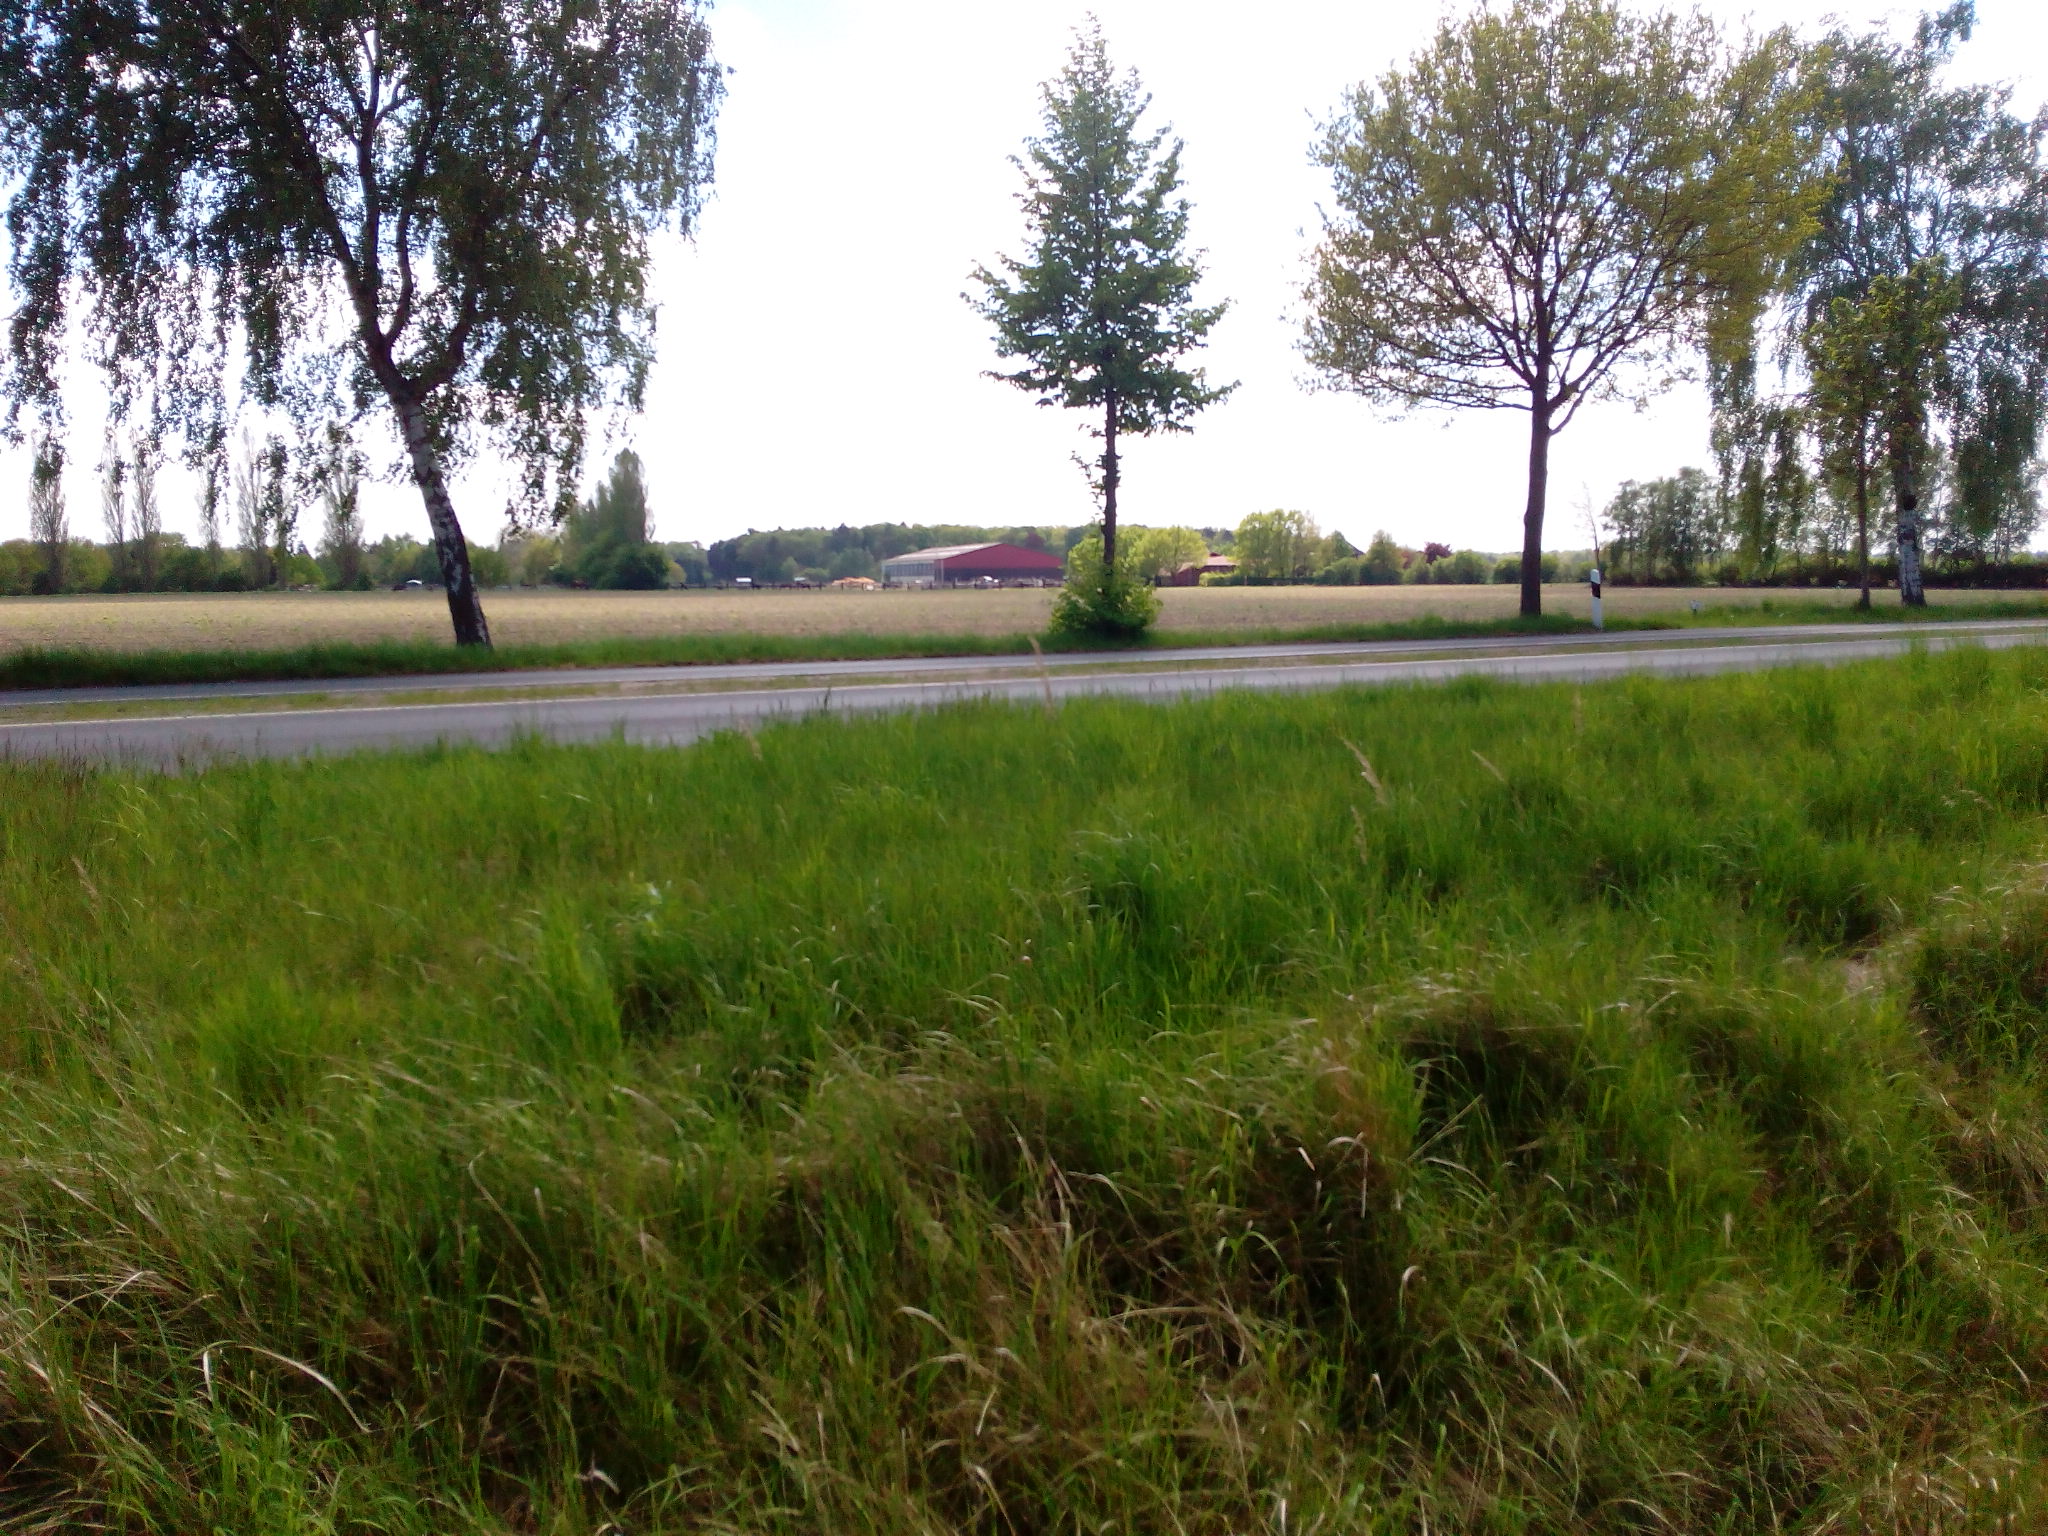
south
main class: Woodland
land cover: Broadleaved woodland
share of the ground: 50 - 75 %
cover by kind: broadleaved forest trees 70 %, herbaceous plants 15 %, consolidated bare surface 15 %
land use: Road transport
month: May
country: DE
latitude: 52.4493
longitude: 9.9265
